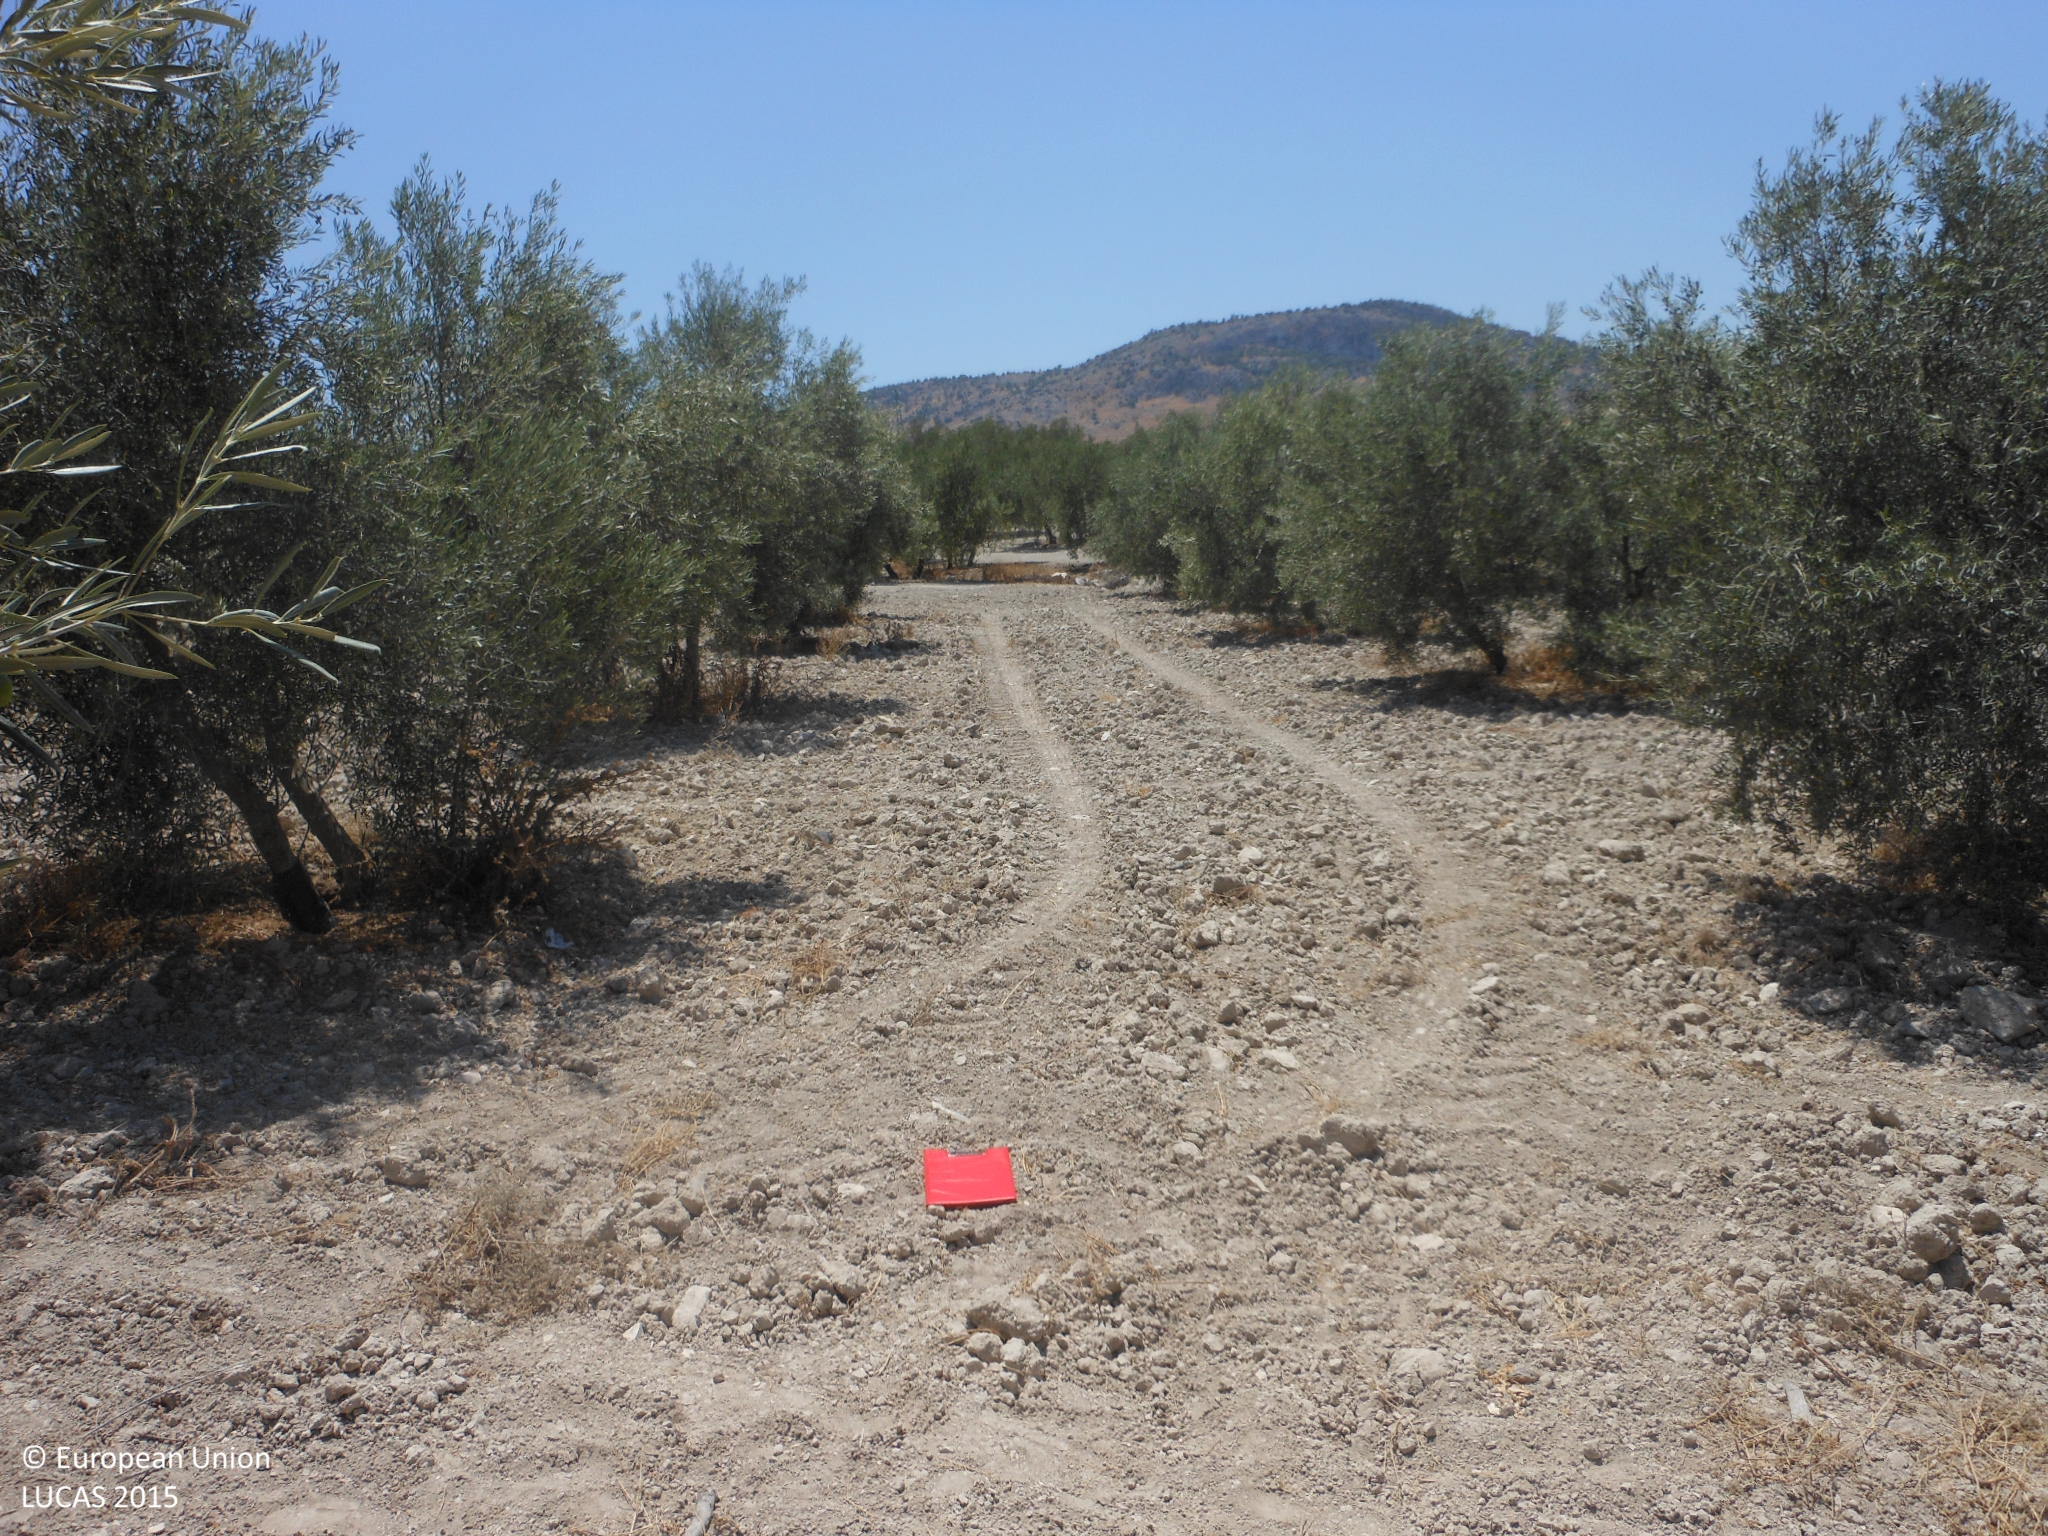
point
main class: Cropland
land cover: Olive groves
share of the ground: 25 - 50 %
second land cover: Other bare soil
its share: > 75 %
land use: Agriculture (excluding fallow land and kitchen gardens)
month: June
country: ES
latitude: 37.3047
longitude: -4.8871
